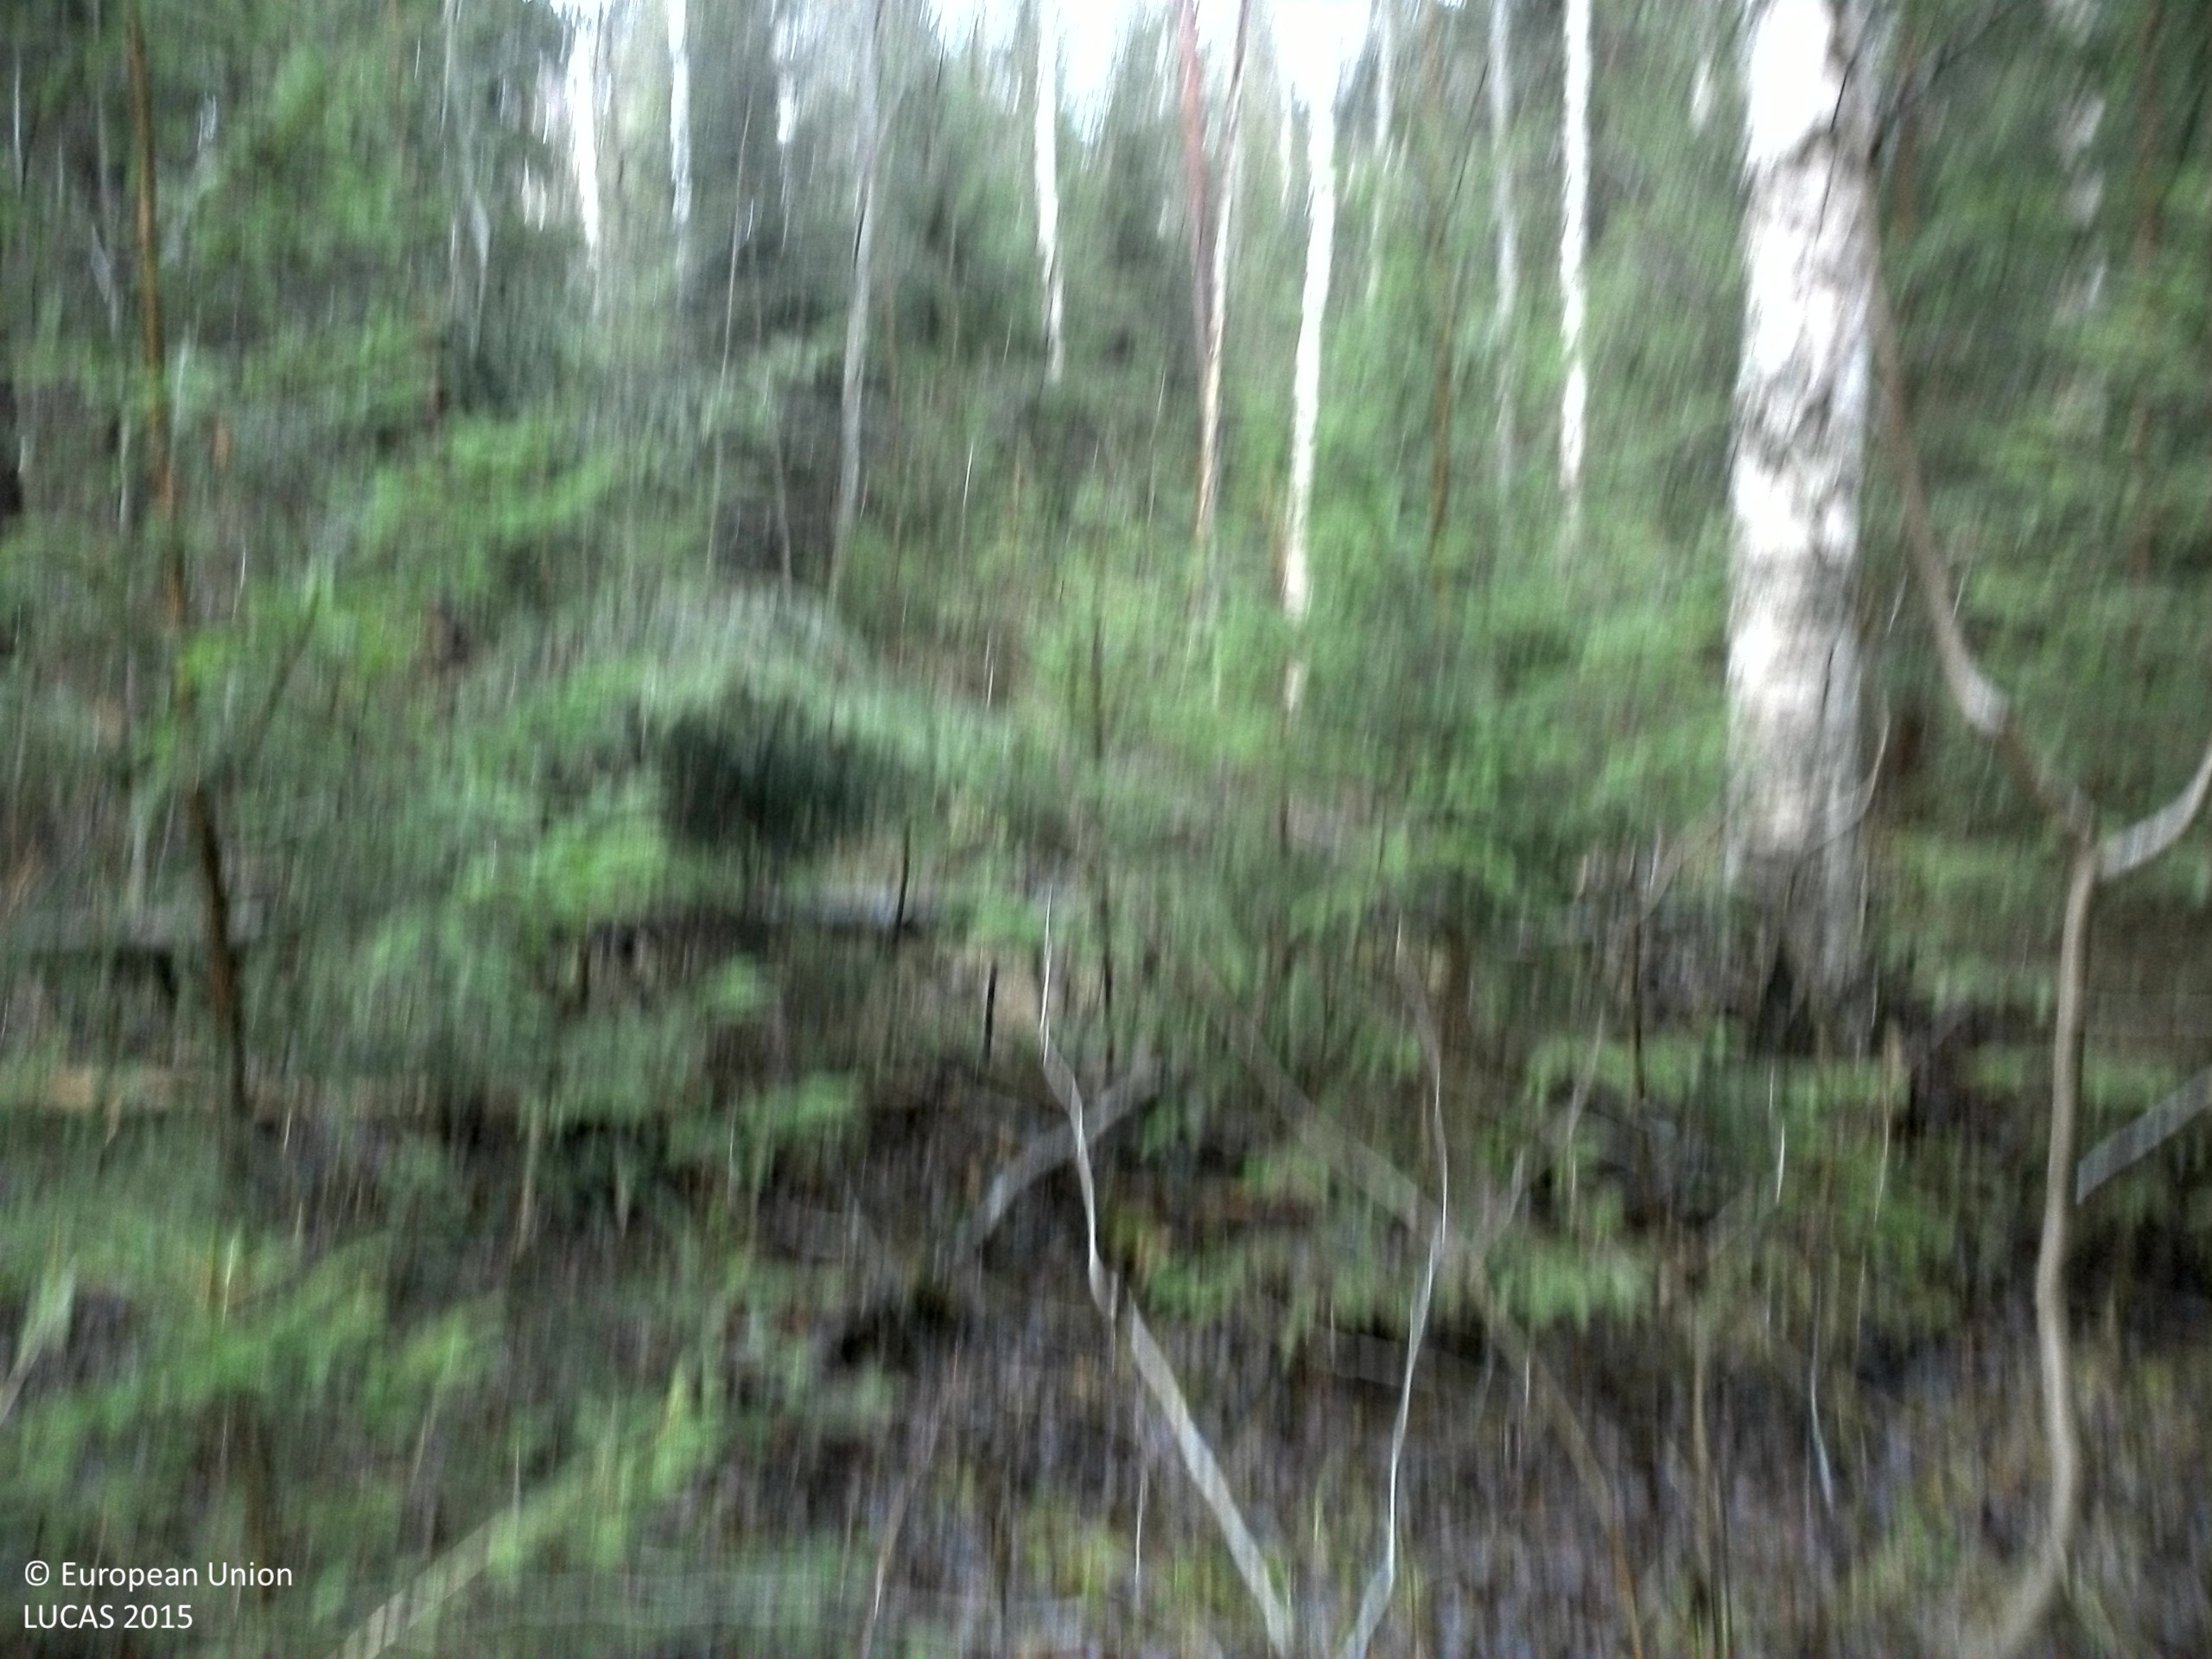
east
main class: Woodland
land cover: Spruce dominated mixed woodland
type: boreal forest
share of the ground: 50 - 75 %
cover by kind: coniferous forest trees 35 %, broadleaved forest trees 35 %, shrubs 10 %, herbaceous plants 10 %, lichens and mosses 10 %
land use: Forestry
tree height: > 5 m
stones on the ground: 25 - 50 %
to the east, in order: Spruce dominated mixed woodland; Other mixed woodland; Broadleaved woodland; Tracks; Other mixed woodland; Spruce dominated mixed woodland; Spruce dominated coniferous woodland
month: November
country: SE
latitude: 59.9829
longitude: 15.0252
